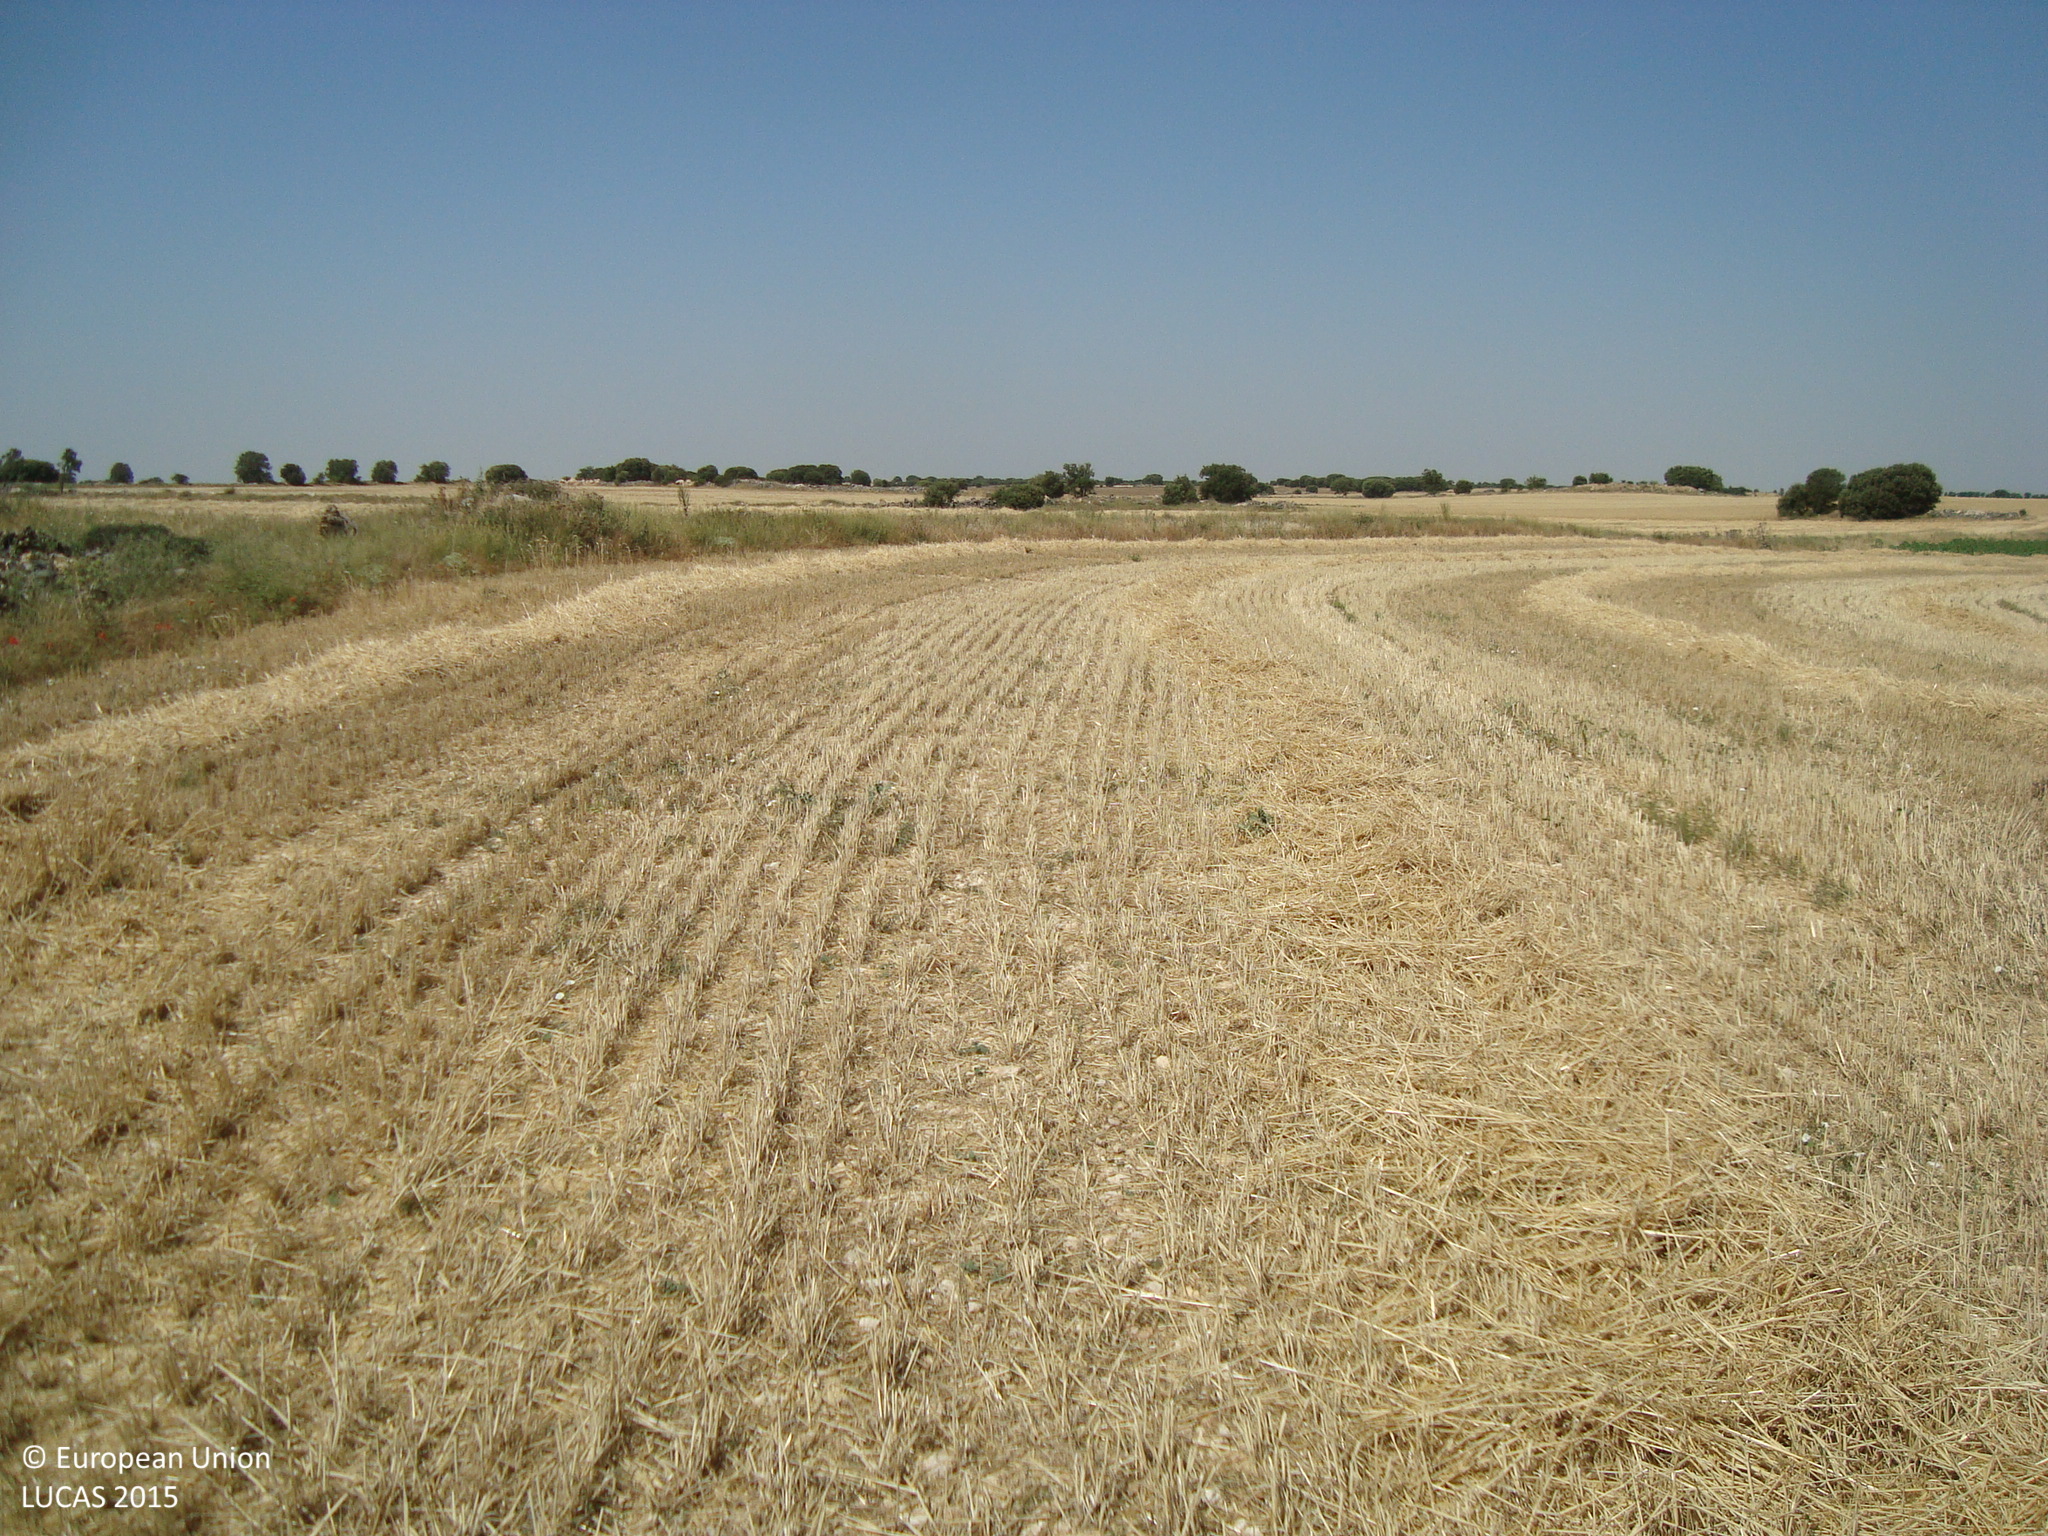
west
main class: Cropland
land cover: Common wheat
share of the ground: > 75 %
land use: Agriculture (excluding fallow land and kitchen gardens)
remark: Harvested field
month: July
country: ES
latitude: 41.8396
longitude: -4.1394
